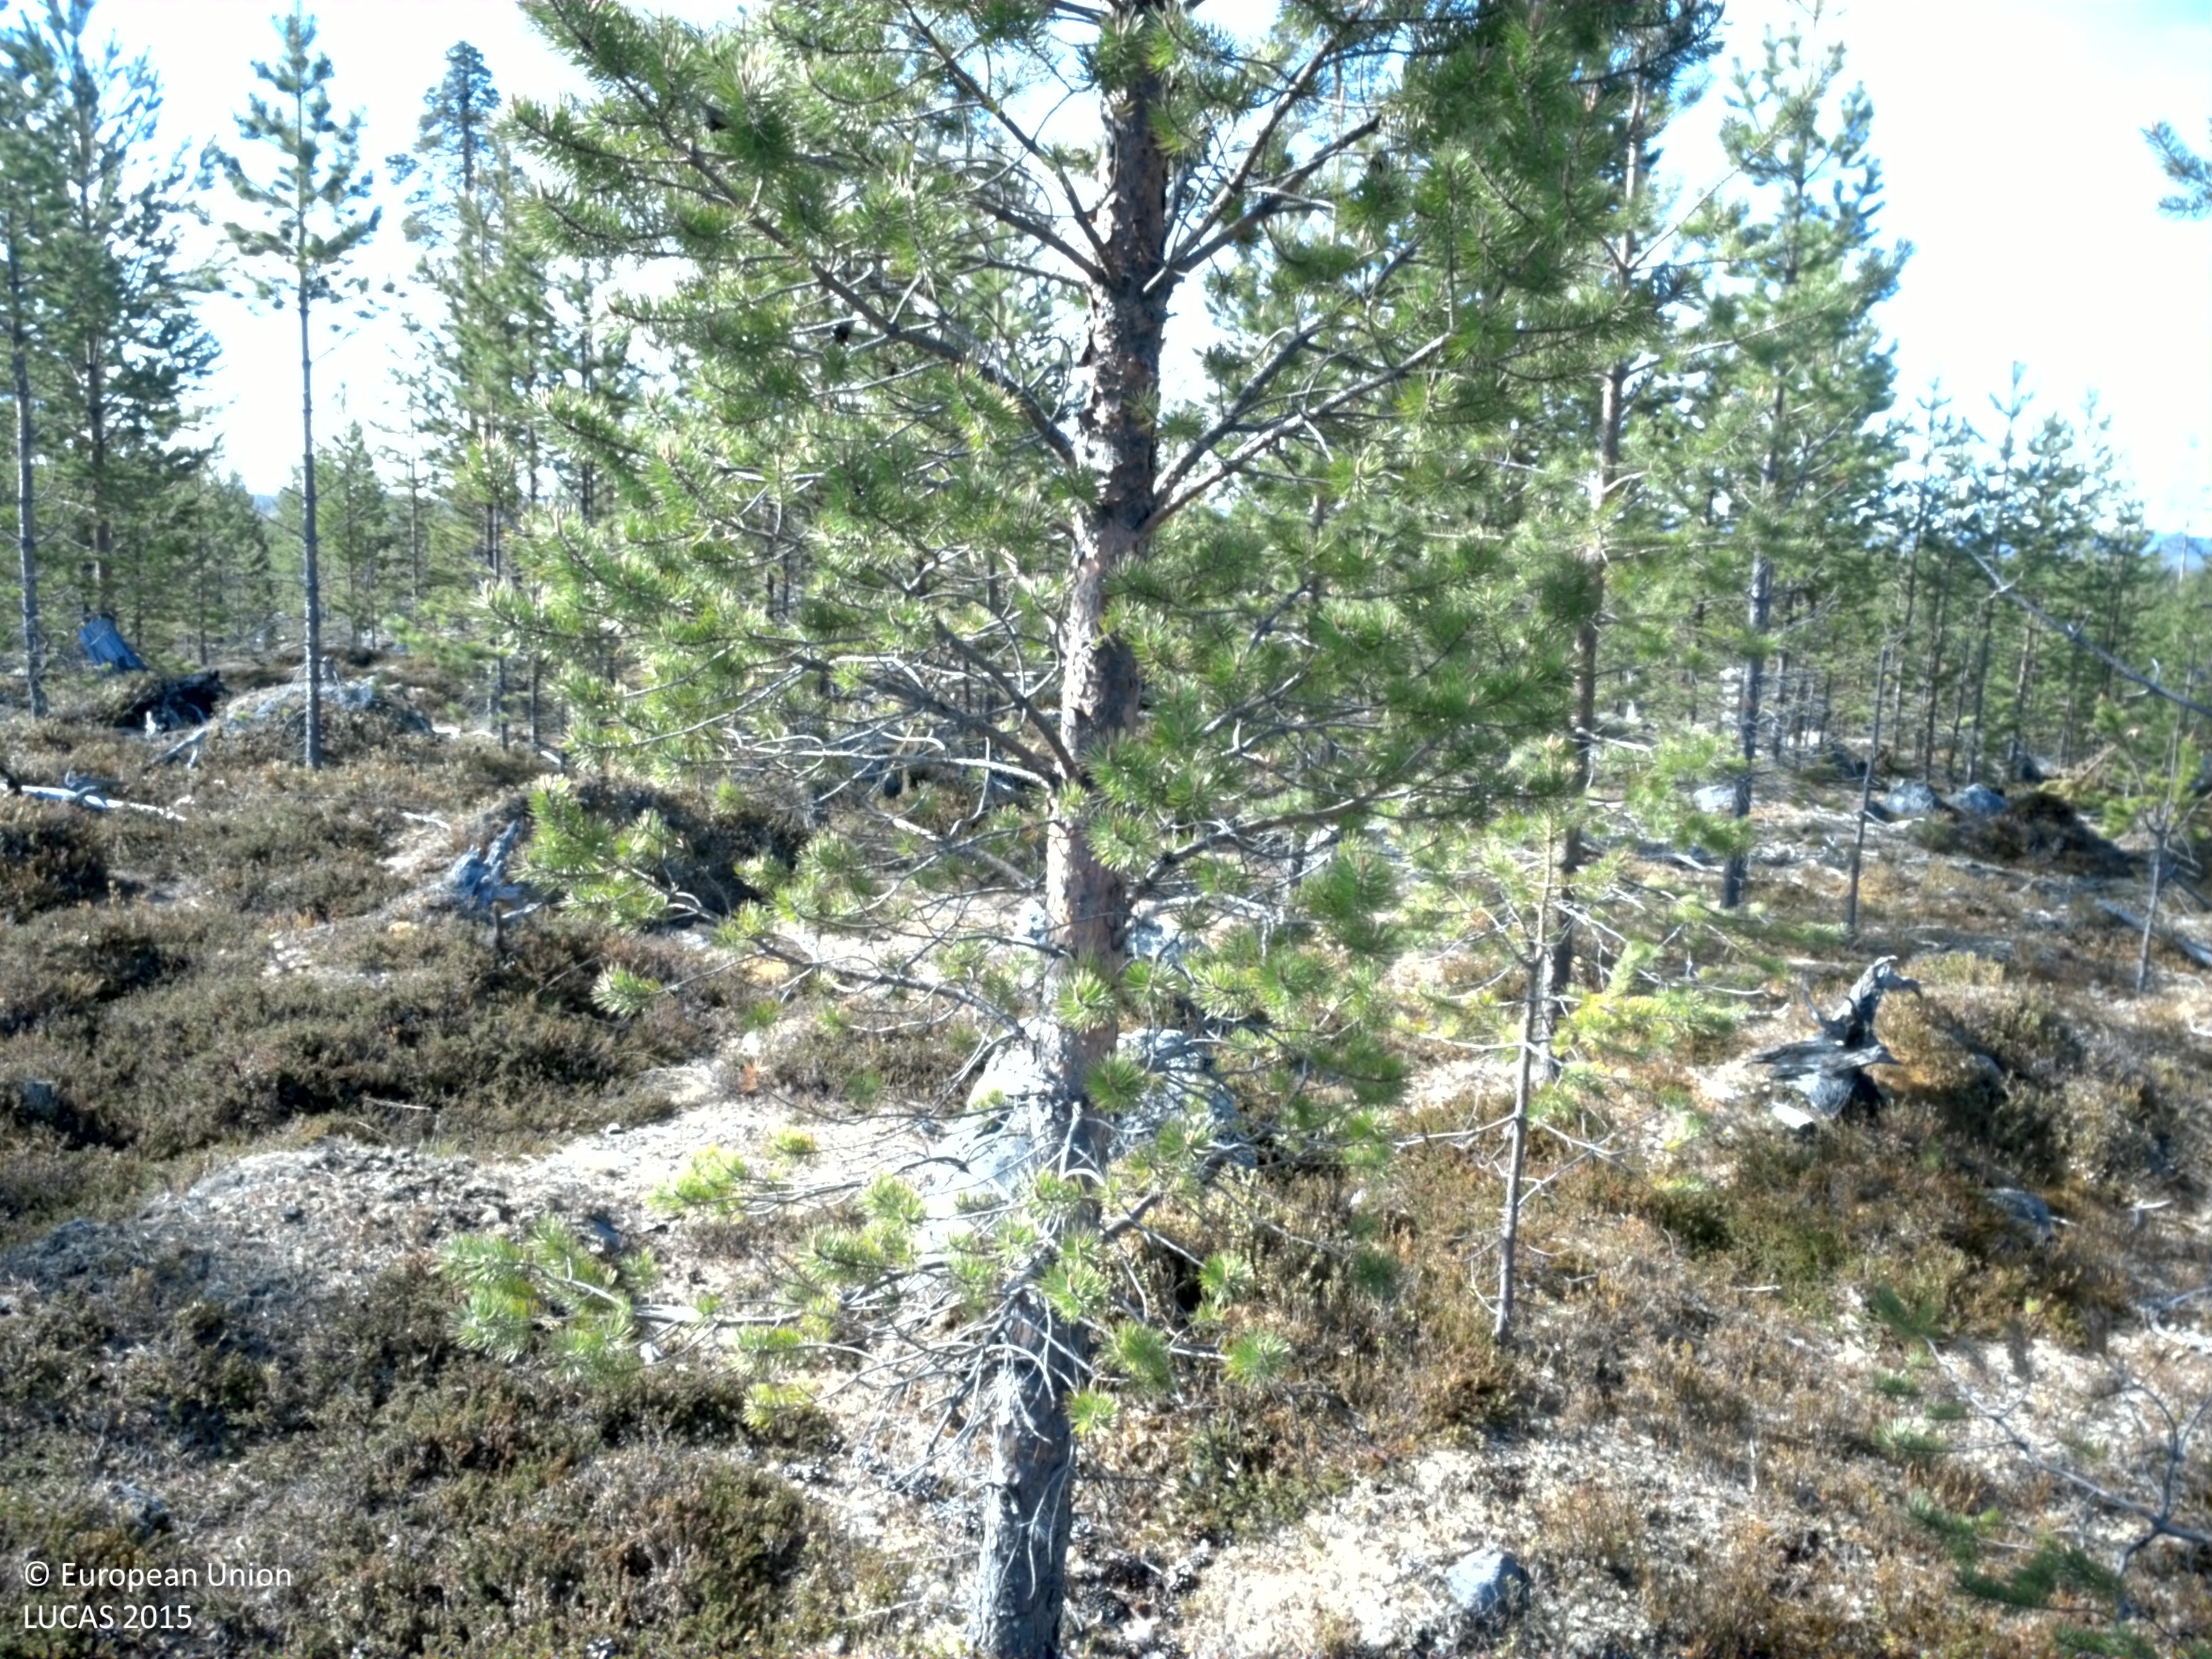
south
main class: Woodland
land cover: Pine dominated coniferous woodland
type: boreal forest
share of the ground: 10 - 25 %
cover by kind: shrubs 55 %, coniferous forest trees 20 %, consolidated bare surface 15 %, lichens and mosses 10 %
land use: Forestry
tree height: < 5 m
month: June
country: SE
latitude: 65.9413
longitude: 18.7276
